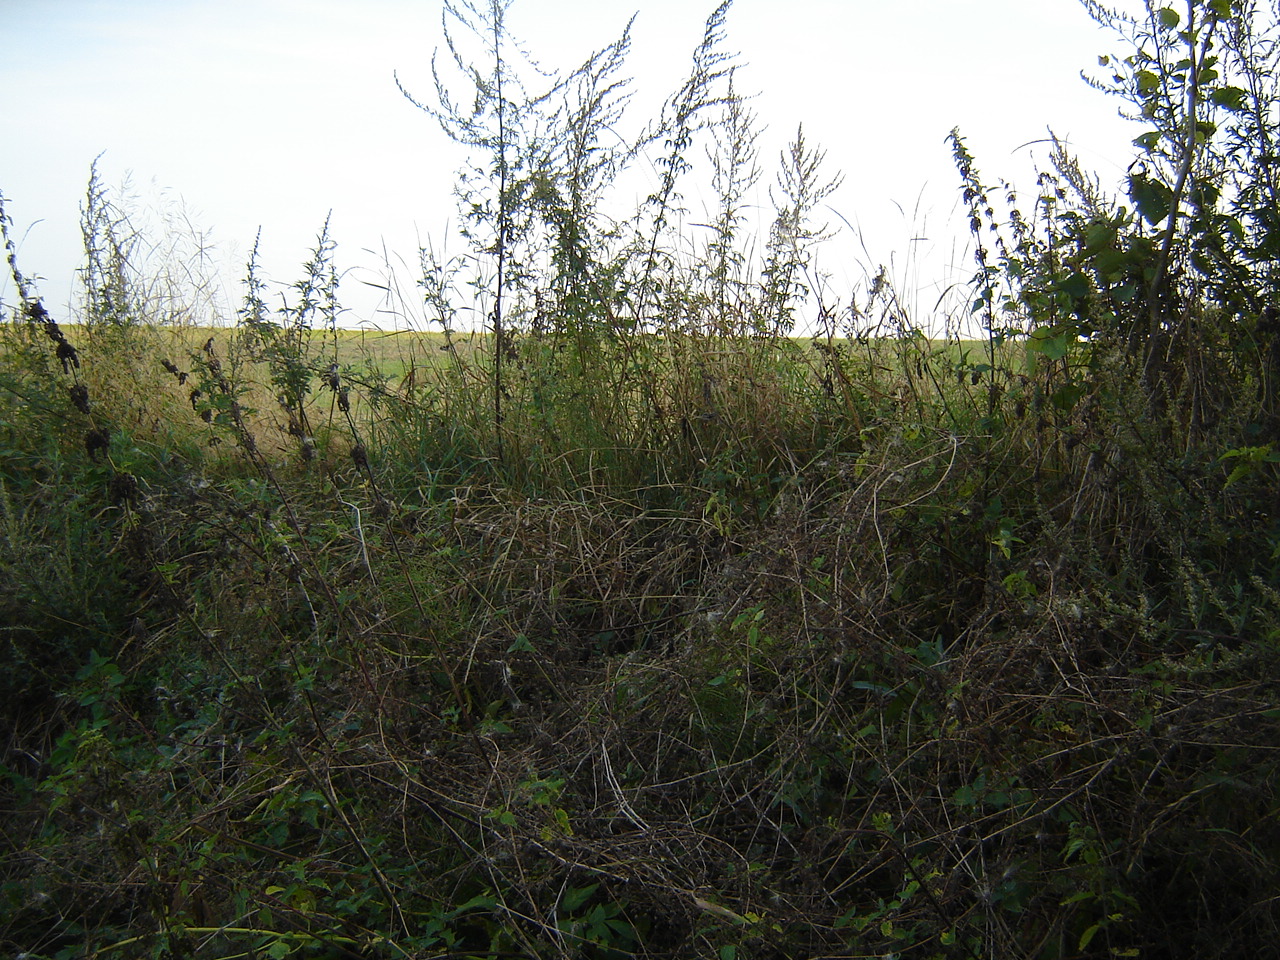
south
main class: Grassland
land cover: Spontaneously vegetated surfaces
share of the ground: > 75 %
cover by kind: herbaceous plants 100 %
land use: Semi-natural and natural areas not in use
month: August
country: LT
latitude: 54.7908
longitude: 24.8062
